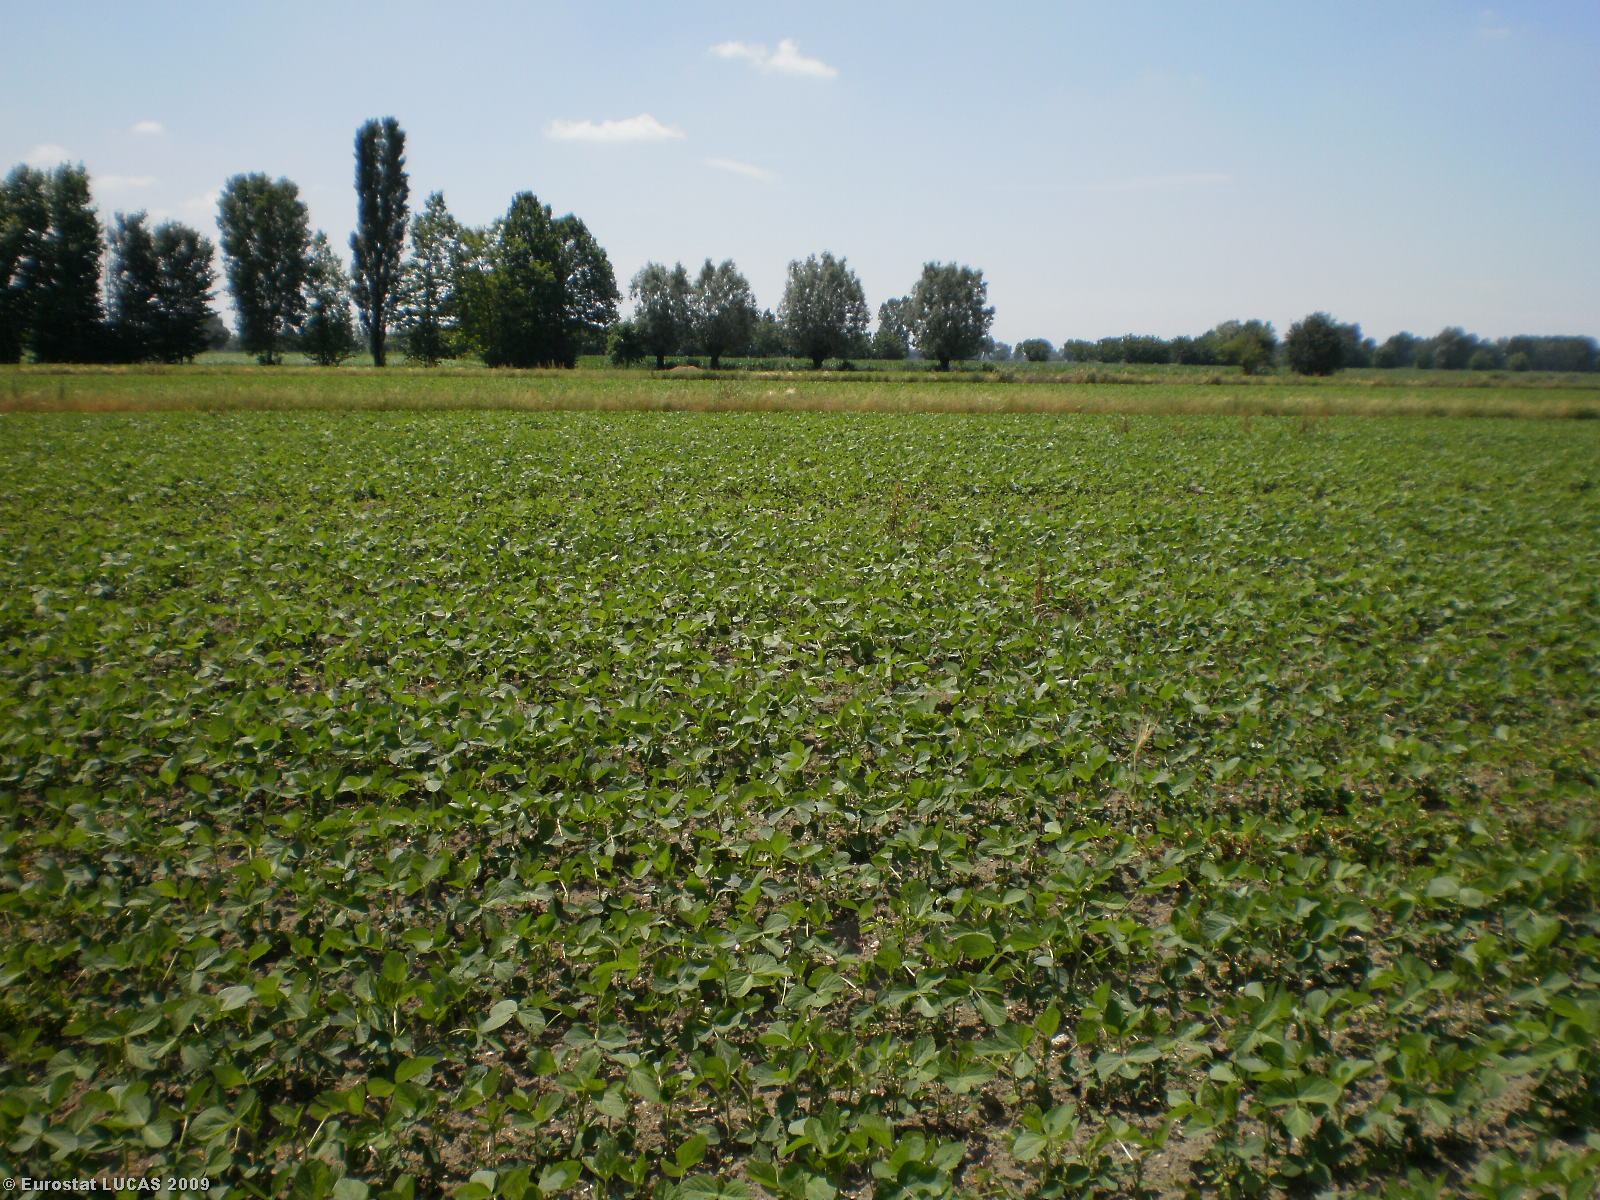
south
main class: Cropland
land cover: Soya
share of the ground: 50 - 75 %
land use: Agriculture (excluding fallow land and kitchen gardens)
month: May
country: IT
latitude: 45.2692
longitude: 10.4453
